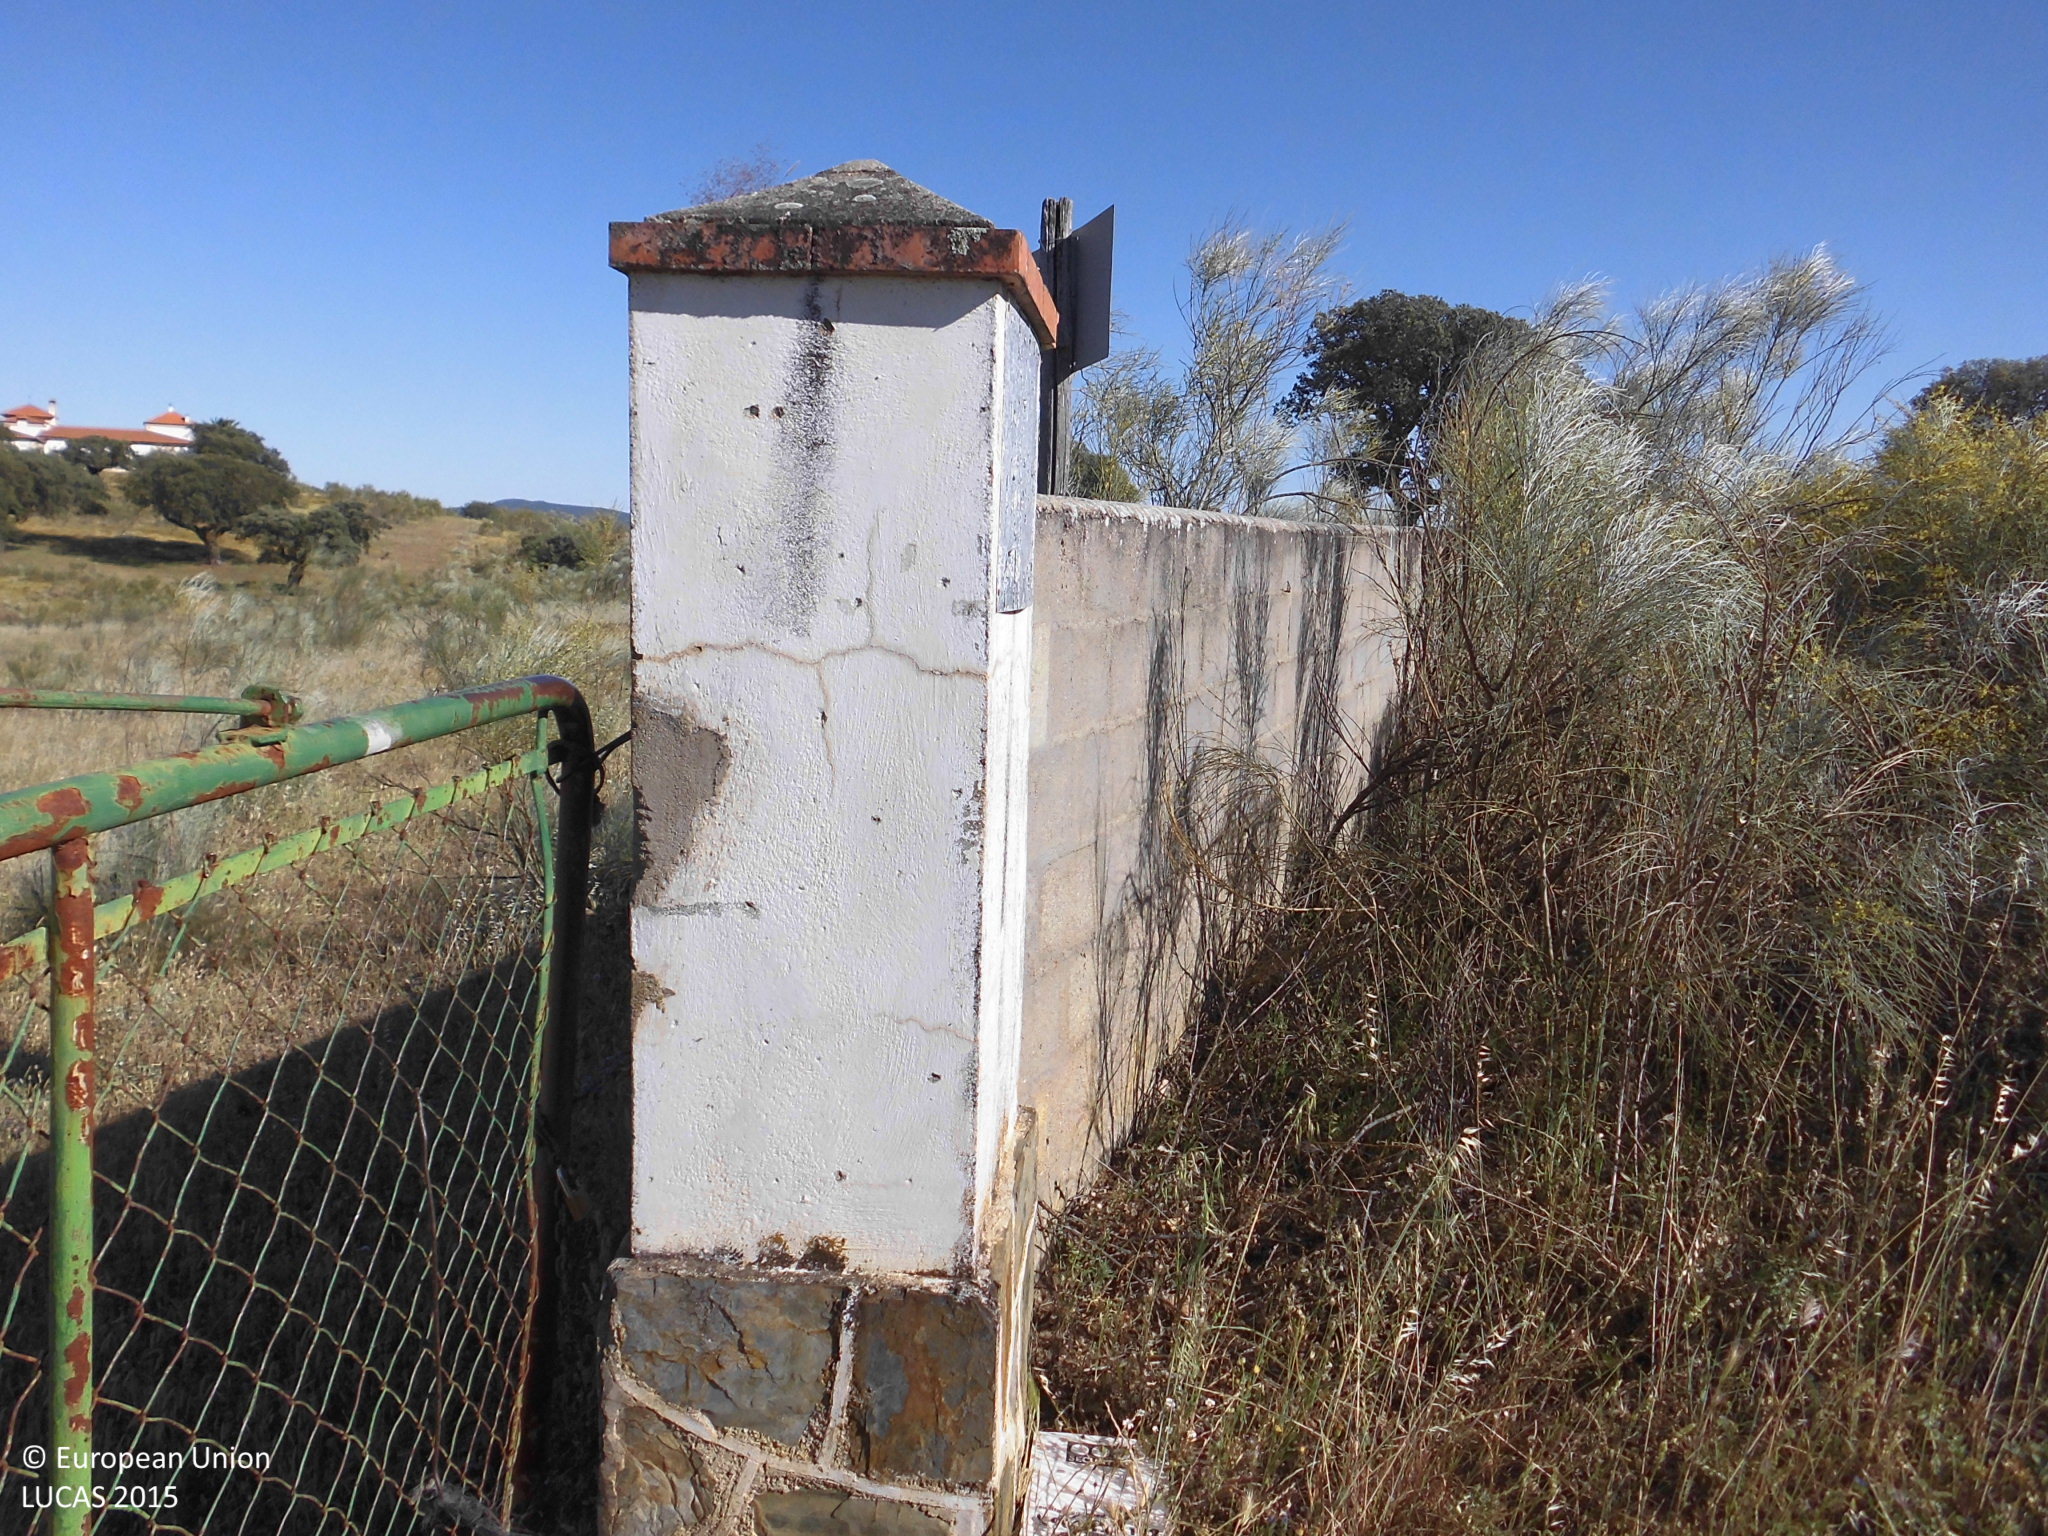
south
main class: Shrubland
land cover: Shrubland without tree cover
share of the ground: 10 - 25 %
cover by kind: herbaceous plants 80 %, shrubs 20 %
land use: Agriculture (excluding fallow land and kitchen gardens)
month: May
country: ES
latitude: 39.4796
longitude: -6.8538
